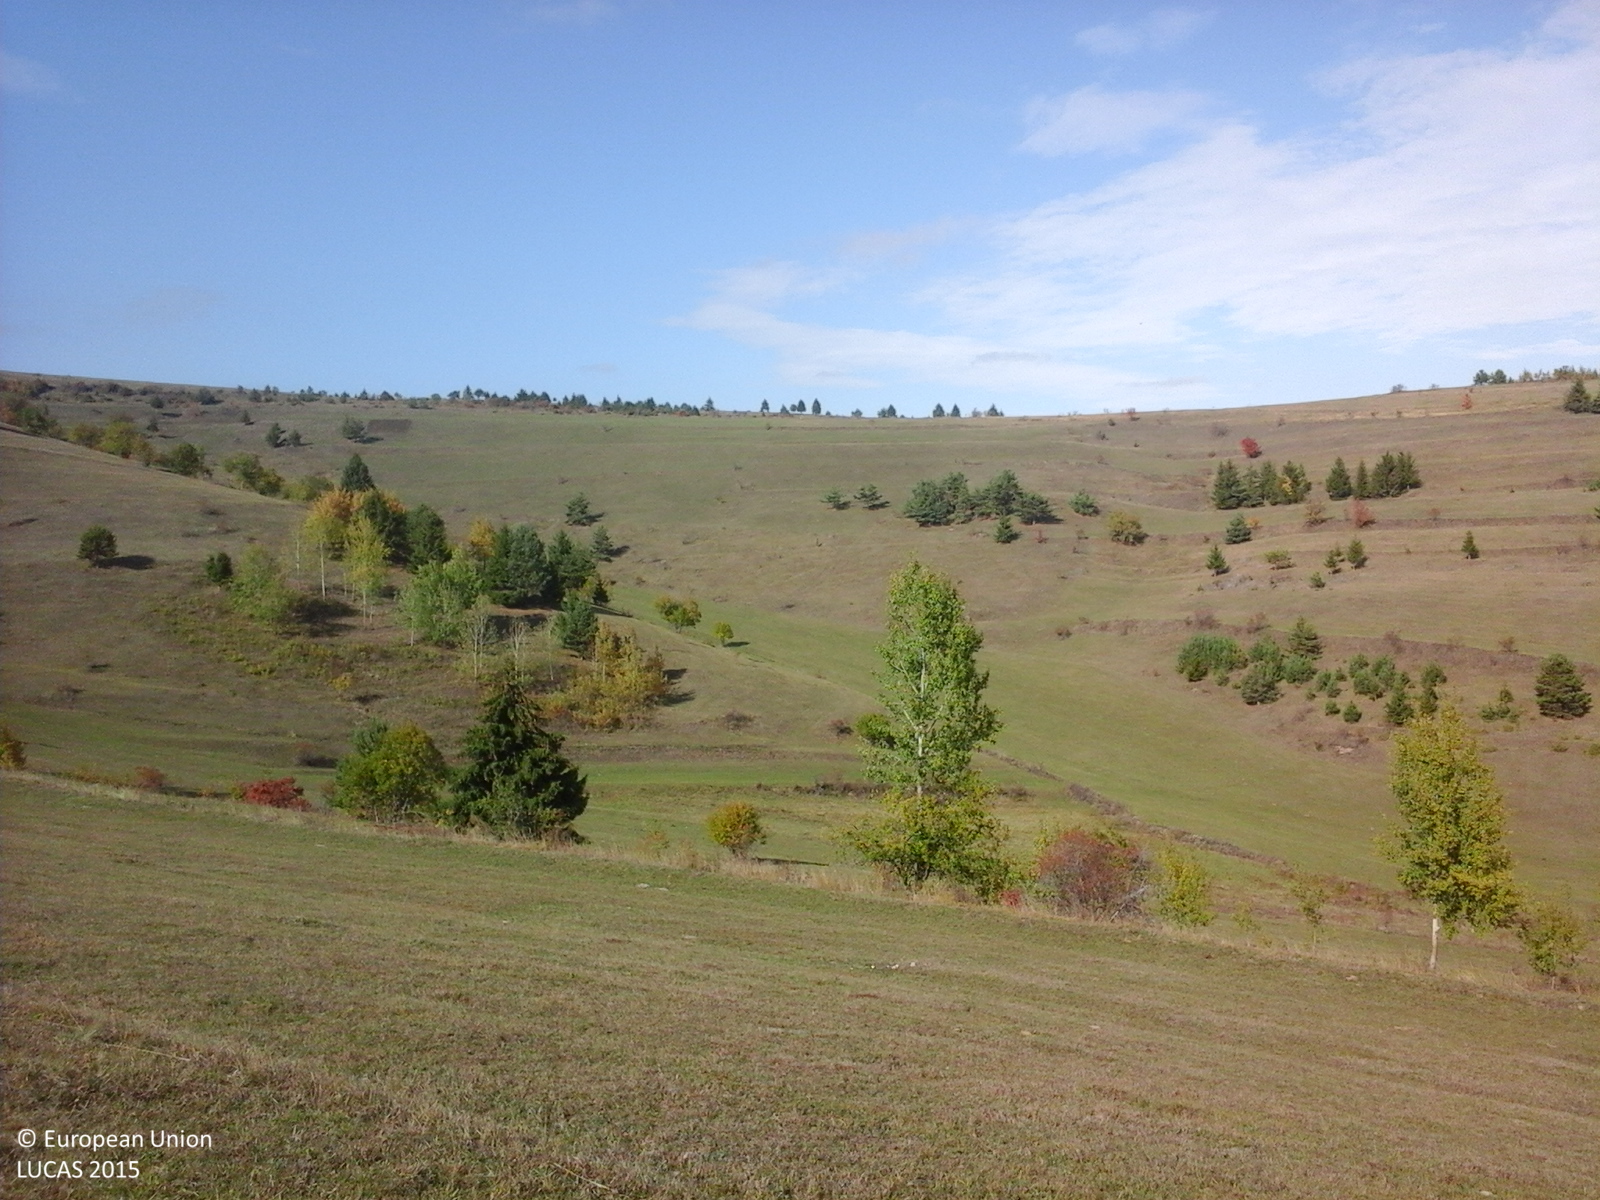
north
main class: Grassland
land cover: Grassland without tree/shrub cover
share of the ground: > 75 %
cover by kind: herbaceous plants 100 %
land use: Agriculture (excluding fallow land and kitchen gardens)
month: October
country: RO
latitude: 46.3225
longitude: 25.9243
